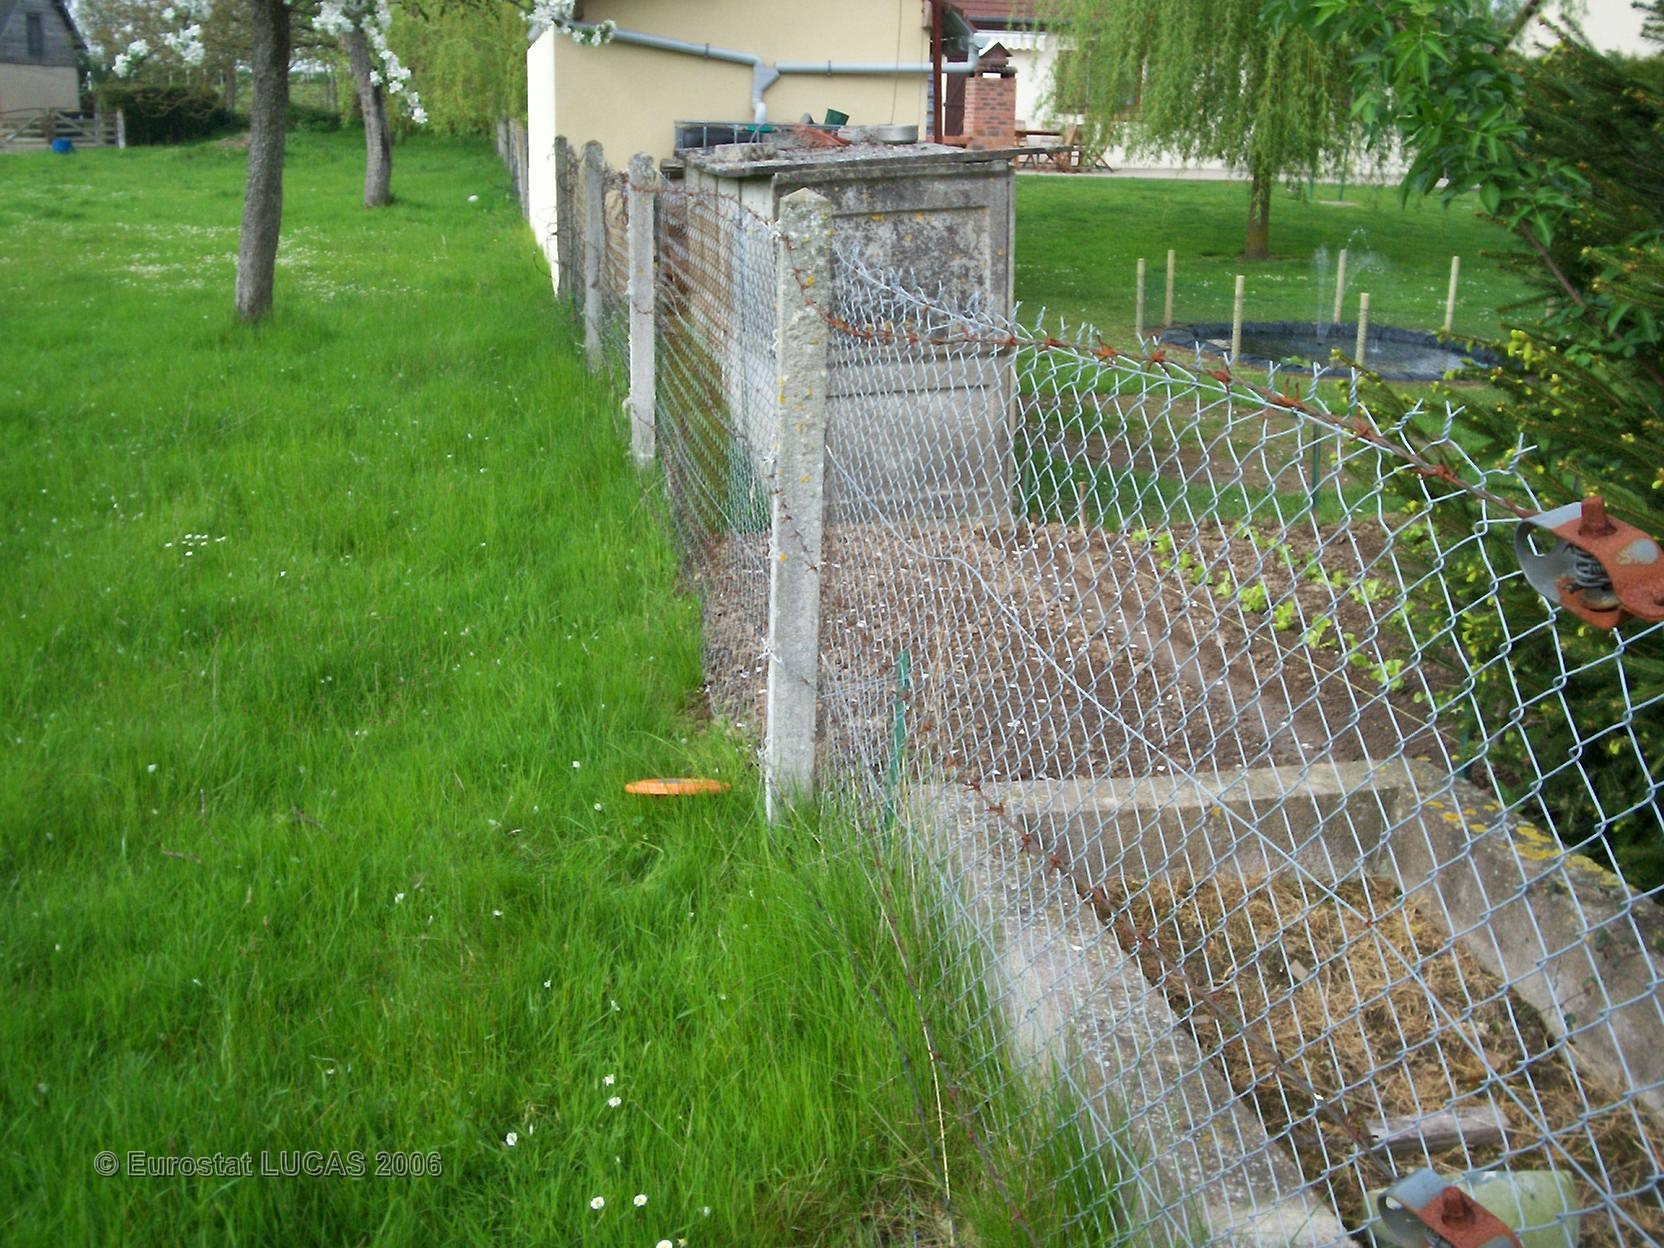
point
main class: Cropland
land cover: Other fresh vegetables
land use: Kitchen garden
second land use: Residential
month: May
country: FR
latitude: 49.1218
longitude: 0.5609
